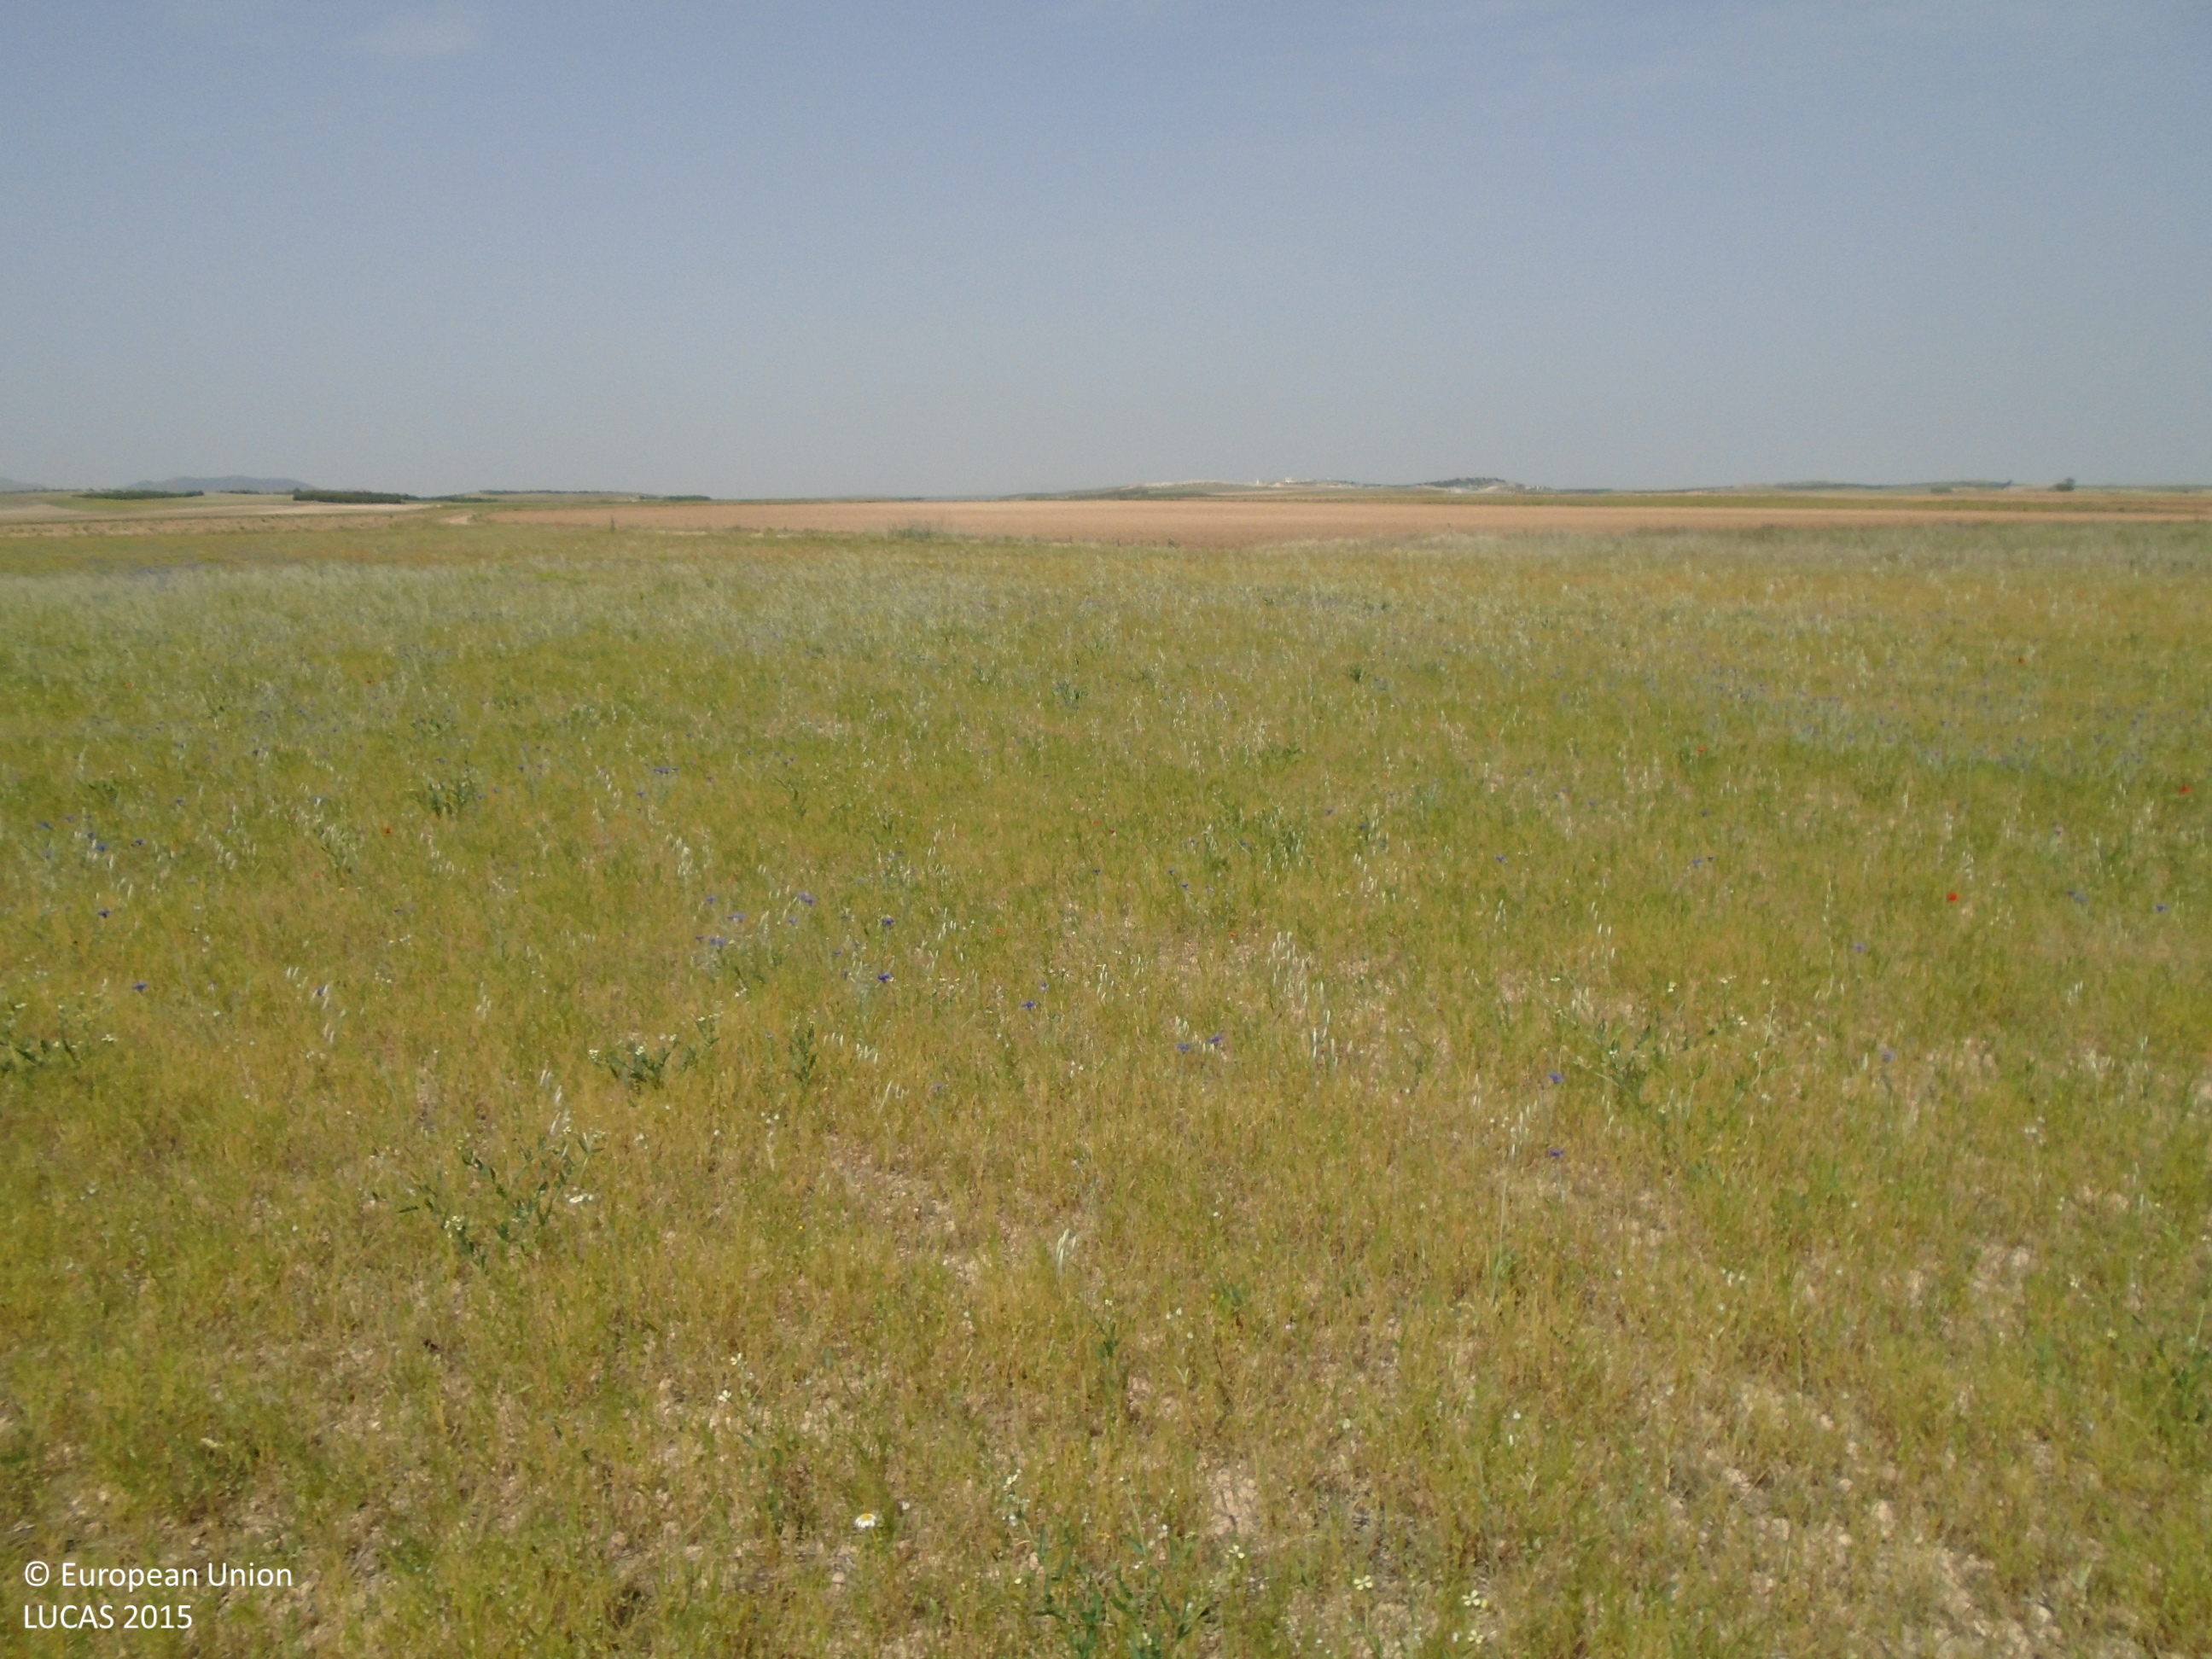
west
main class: Cropland
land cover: Dry pulses
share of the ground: > 75 %
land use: Agriculture (excluding fallow land and kitchen gardens)
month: May
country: ES
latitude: 39.7339
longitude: -3.6207
